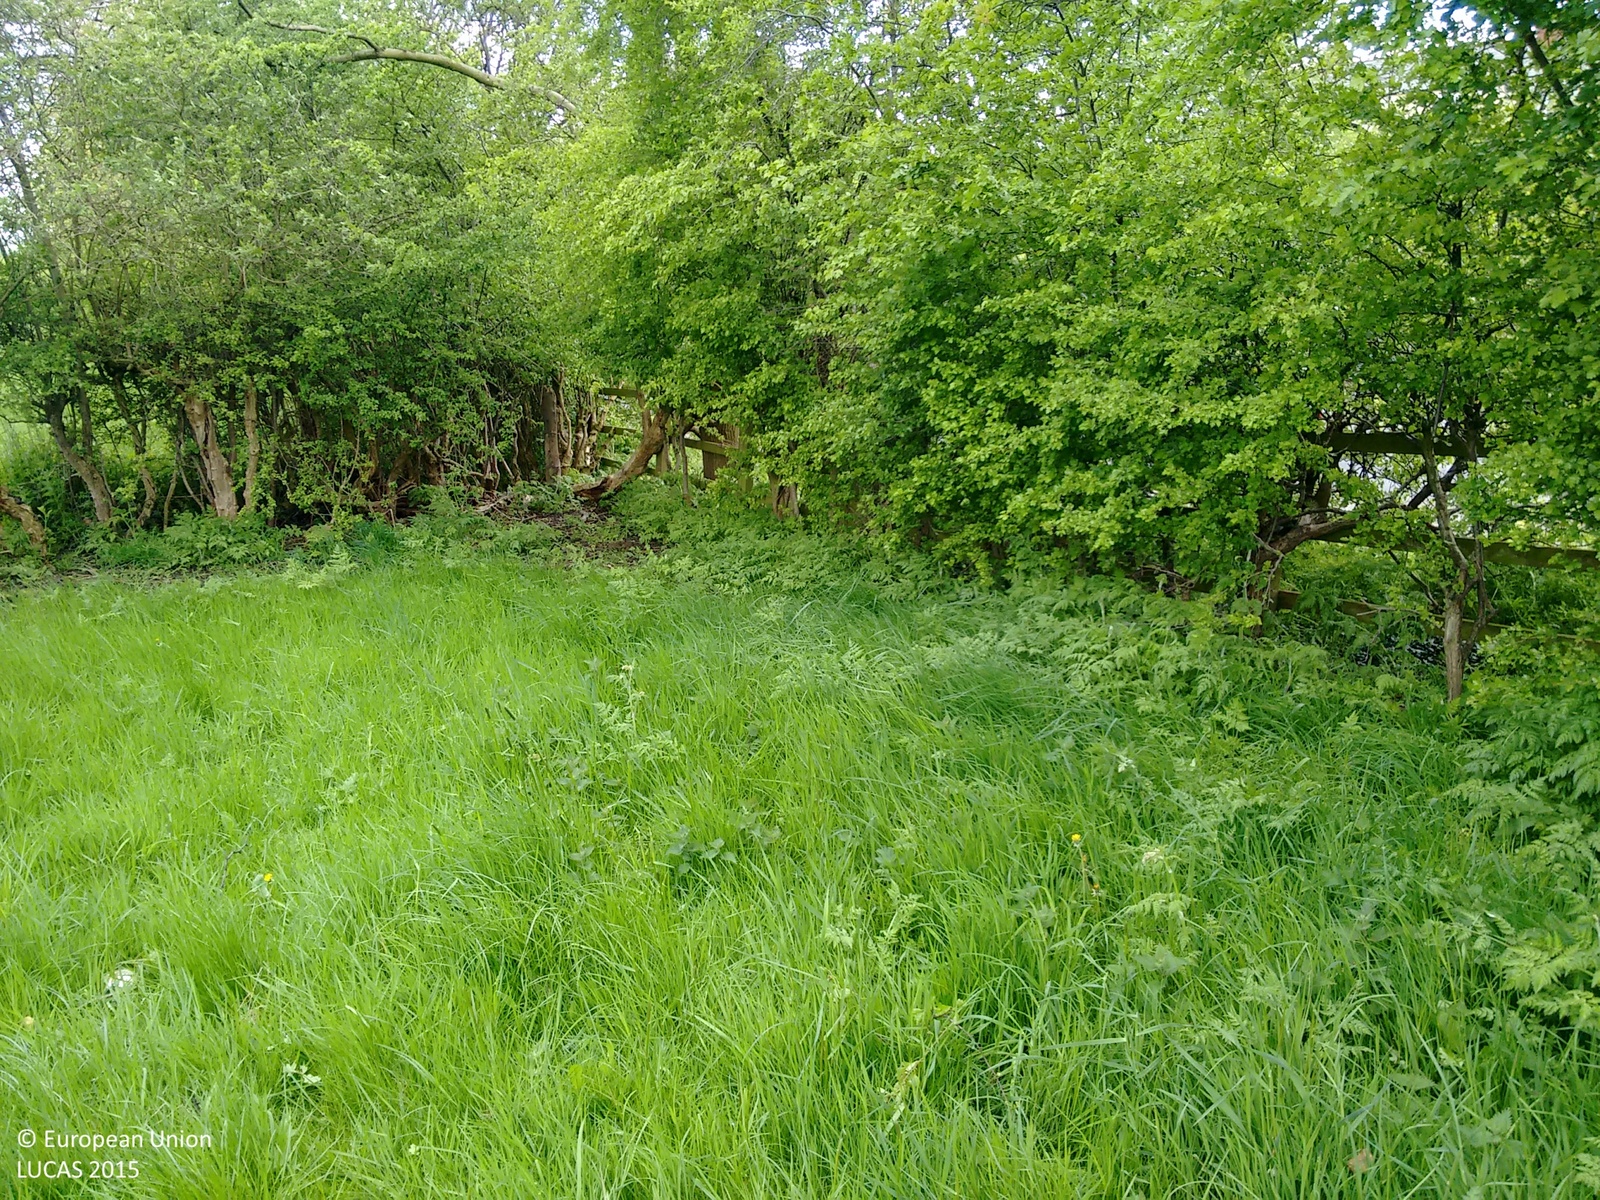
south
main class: Grassland
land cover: Grassland without tree/shrub cover
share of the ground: > 75 %
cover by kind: herbaceous plants 100 %
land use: Agriculture (excluding fallow land and kitchen gardens)
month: May
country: GB
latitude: 53.7430
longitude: -1.6819
